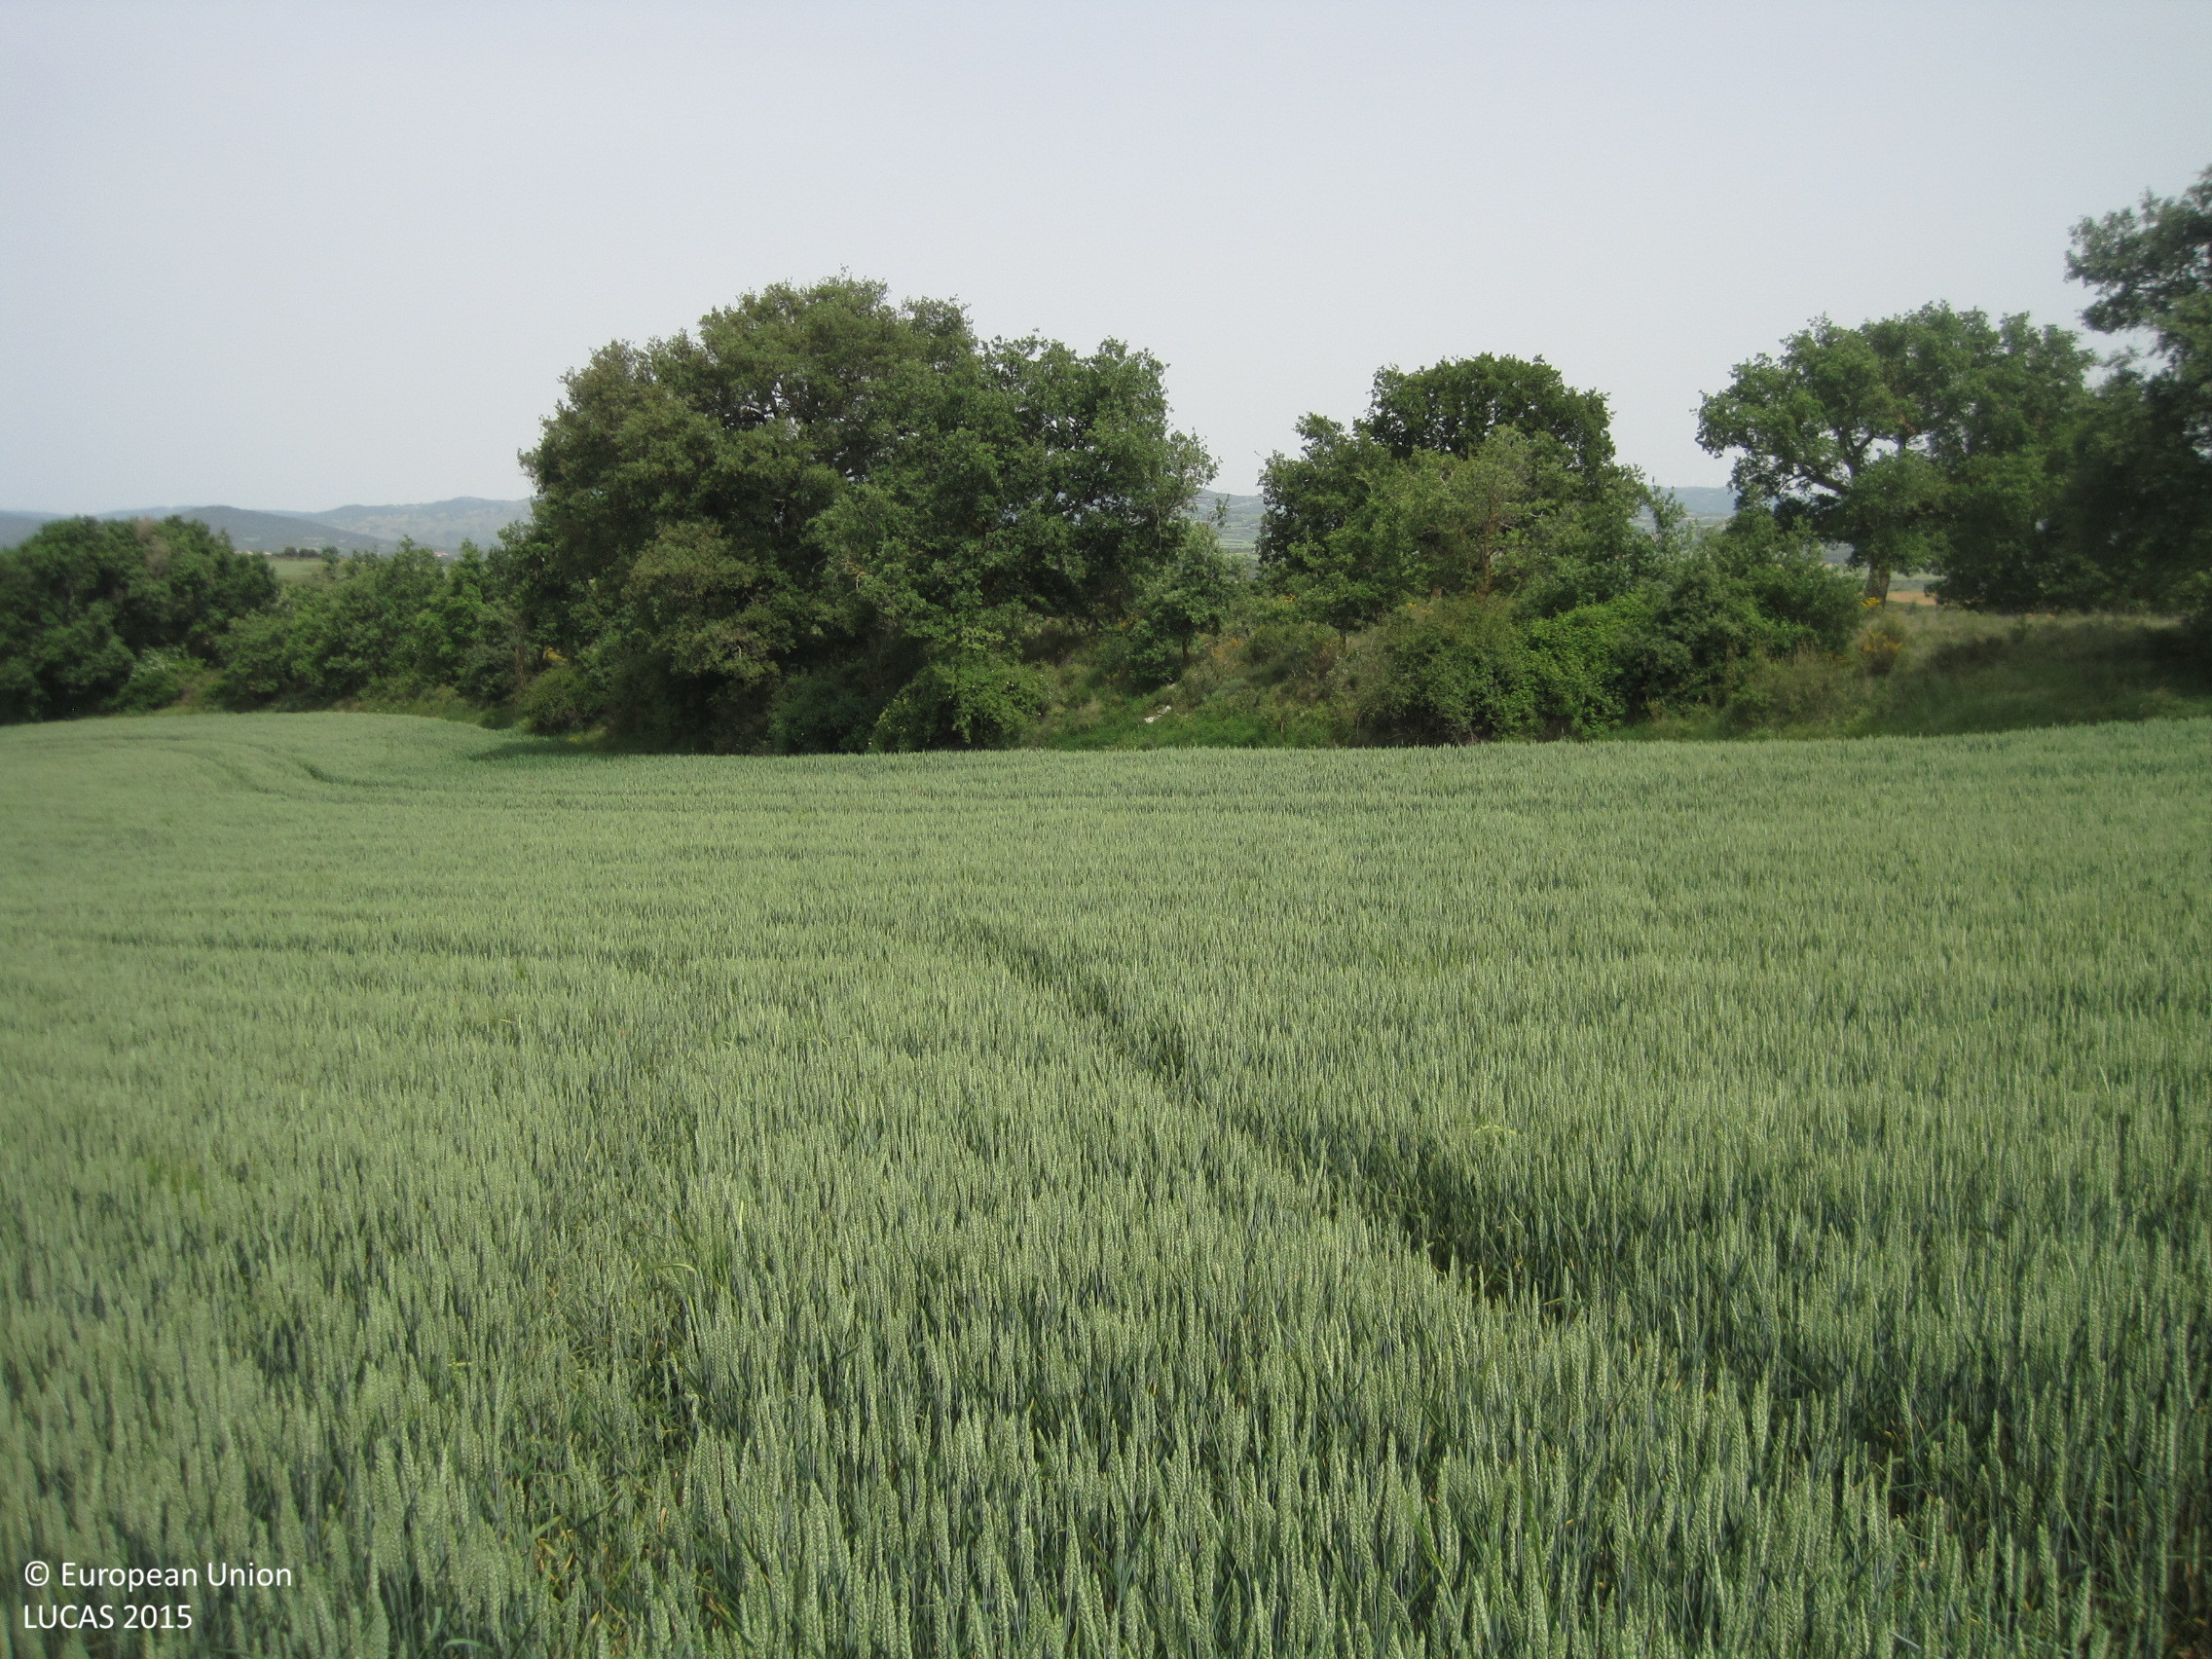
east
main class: Cropland
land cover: Common wheat
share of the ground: > 75 %
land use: Agriculture (excluding fallow land and kitchen gardens)
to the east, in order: Common wheat; Broadleaved woodland; Grassland without tree/shrub cover; Tracks; Grassland with sparse tree/shrub cover; Tracks; Broadleaved woodland
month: May
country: ES
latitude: 42.5960
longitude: -1.6762
